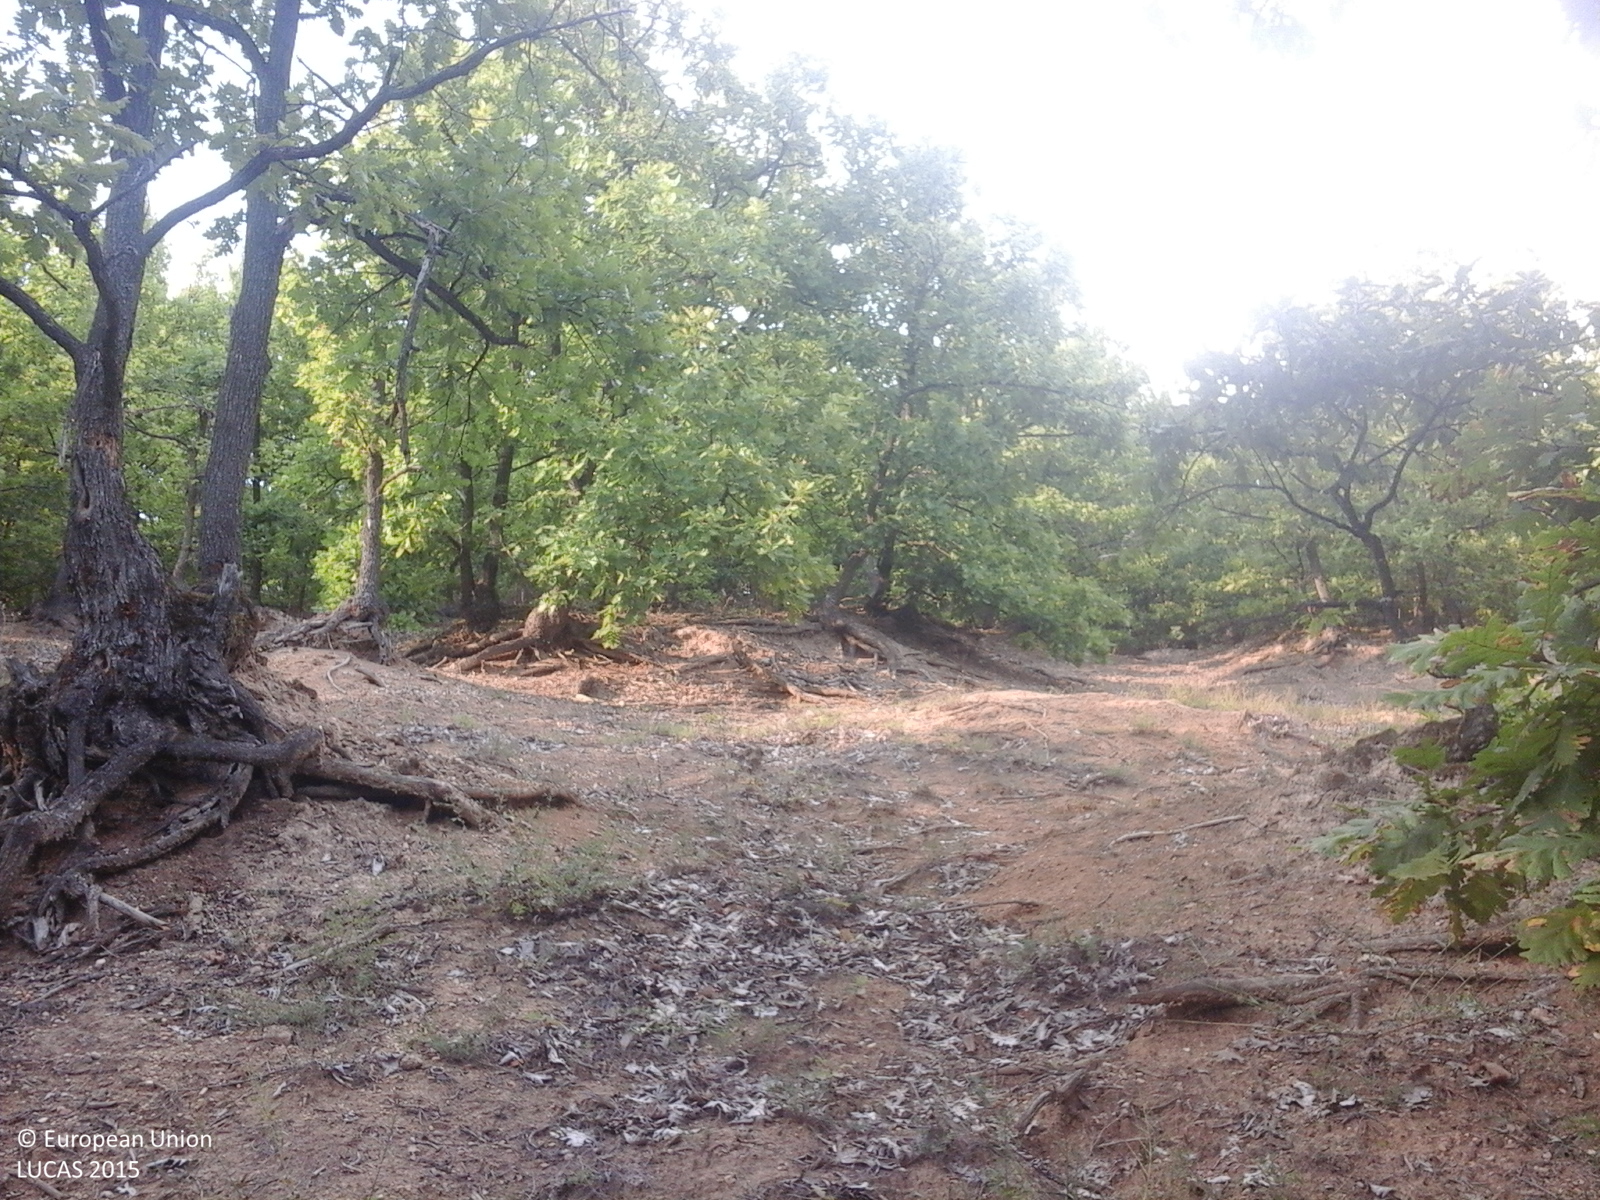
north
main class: Woodland
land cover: Broadleaved woodland
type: acidophilous oak and oak-birch forest
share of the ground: > 75 %
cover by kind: broadleaved forest trees 100 %
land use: Forestry
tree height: > 5 m
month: August
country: RO
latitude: 44.6511
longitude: 23.6374
